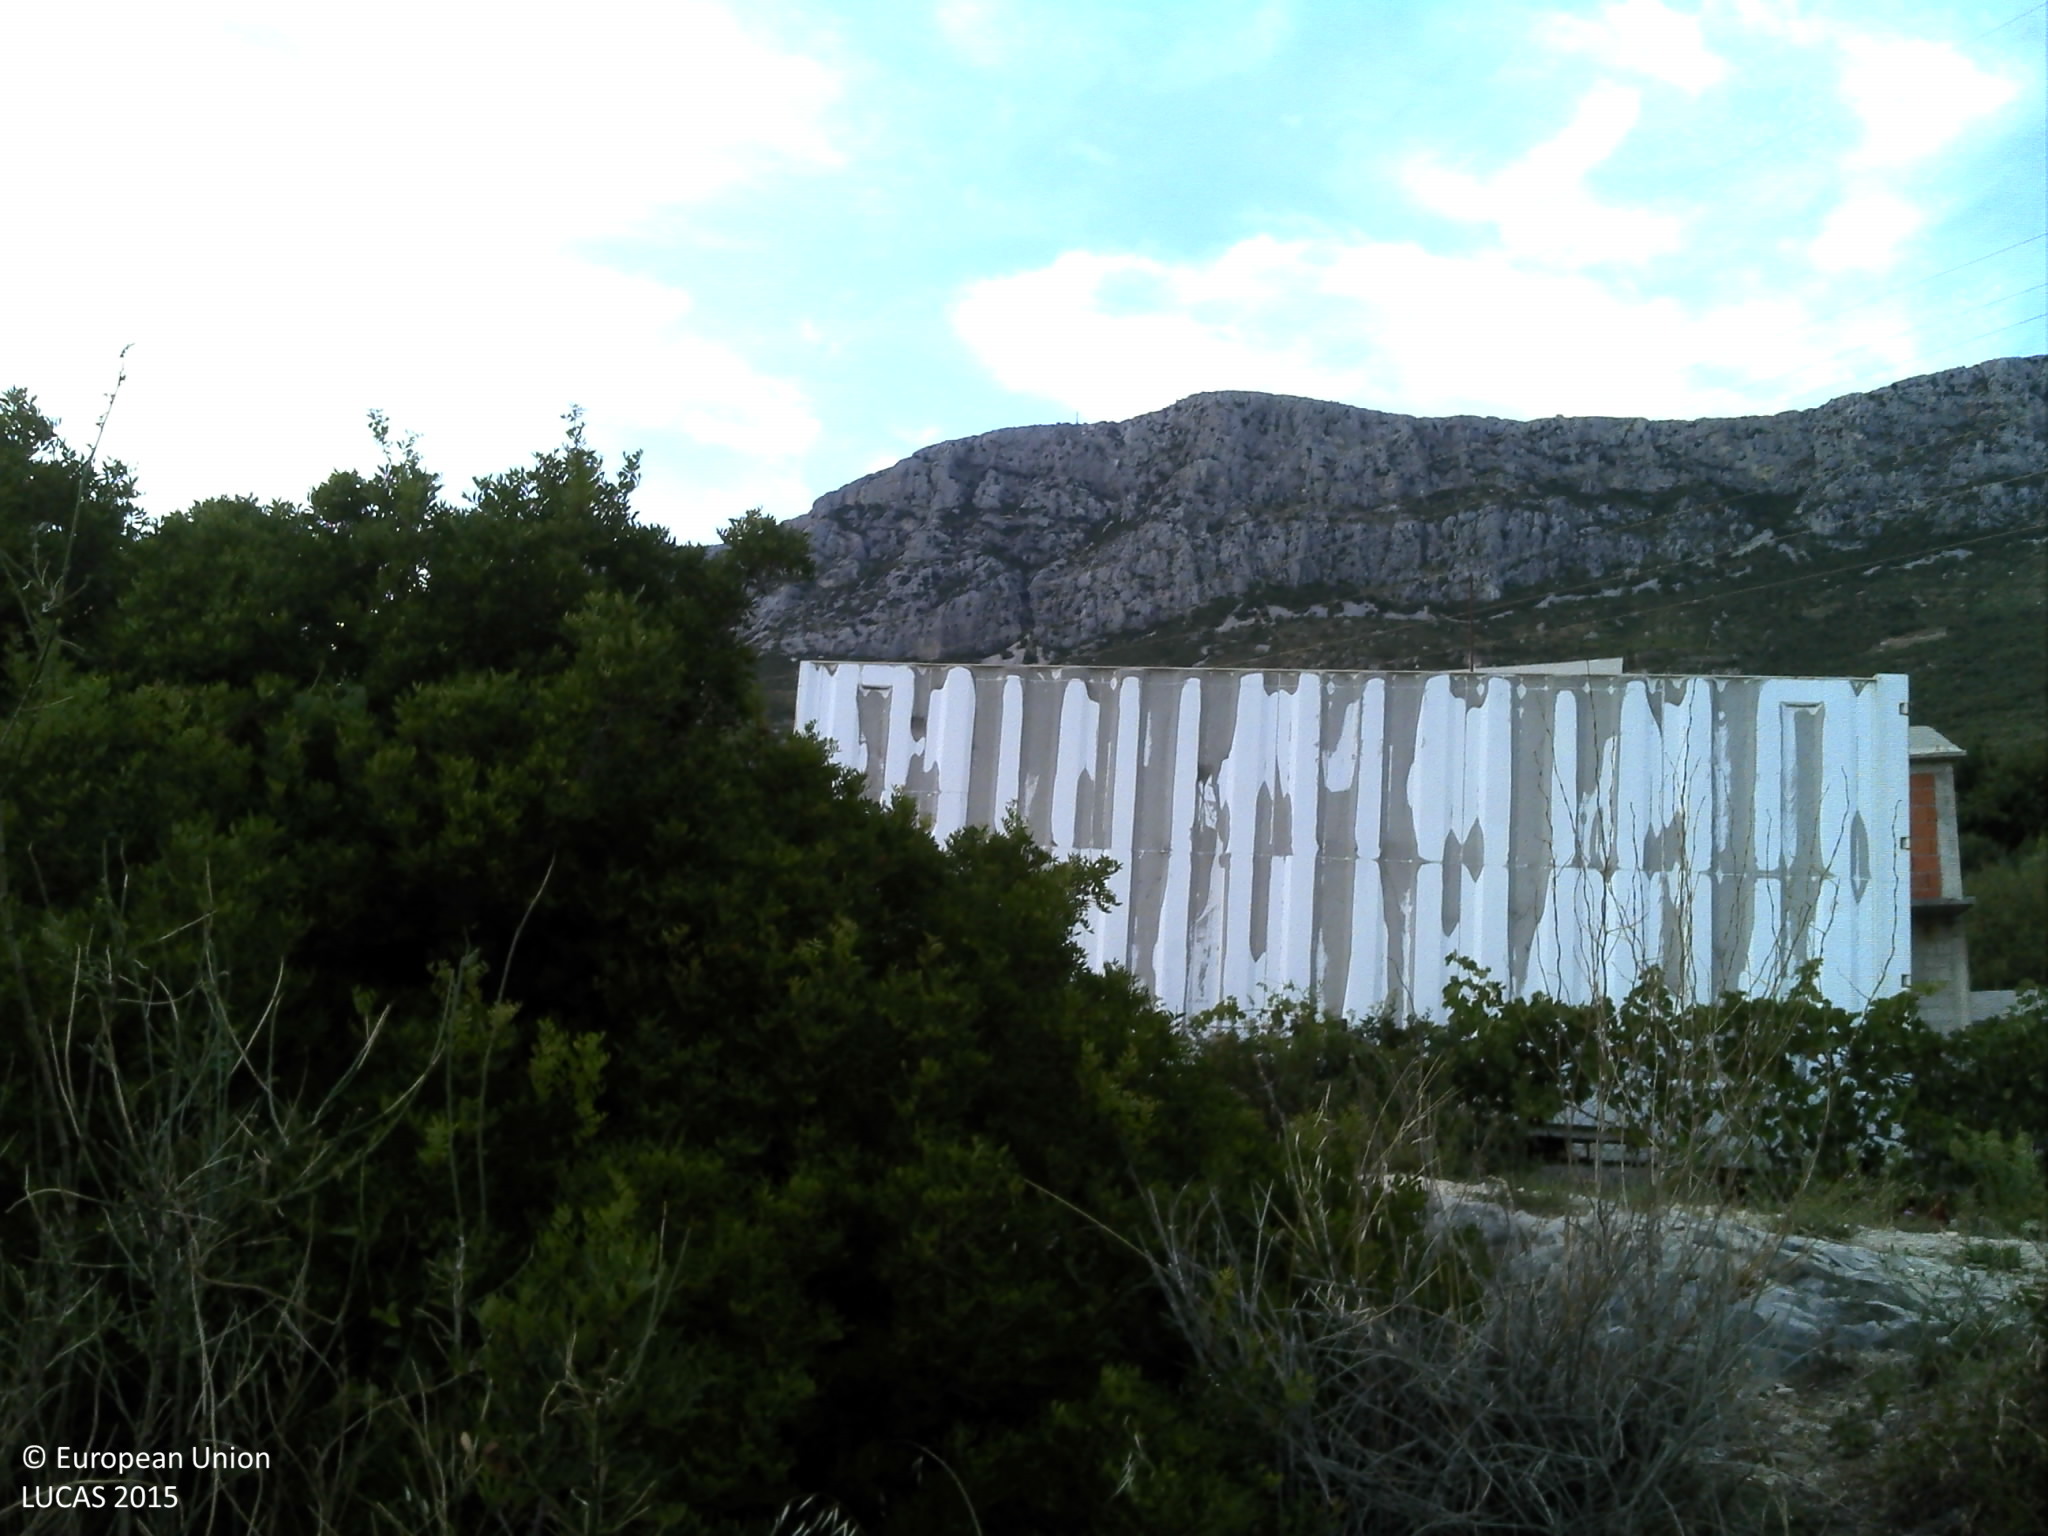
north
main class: Shrubland
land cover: Shrubland without tree cover
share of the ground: 25 - 50 %
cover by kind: shrubs 40 %, herbaceous plants 30 %, consolidated bare surface 10 %
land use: Residential
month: September
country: HR
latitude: 43.5549
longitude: 16.4155
